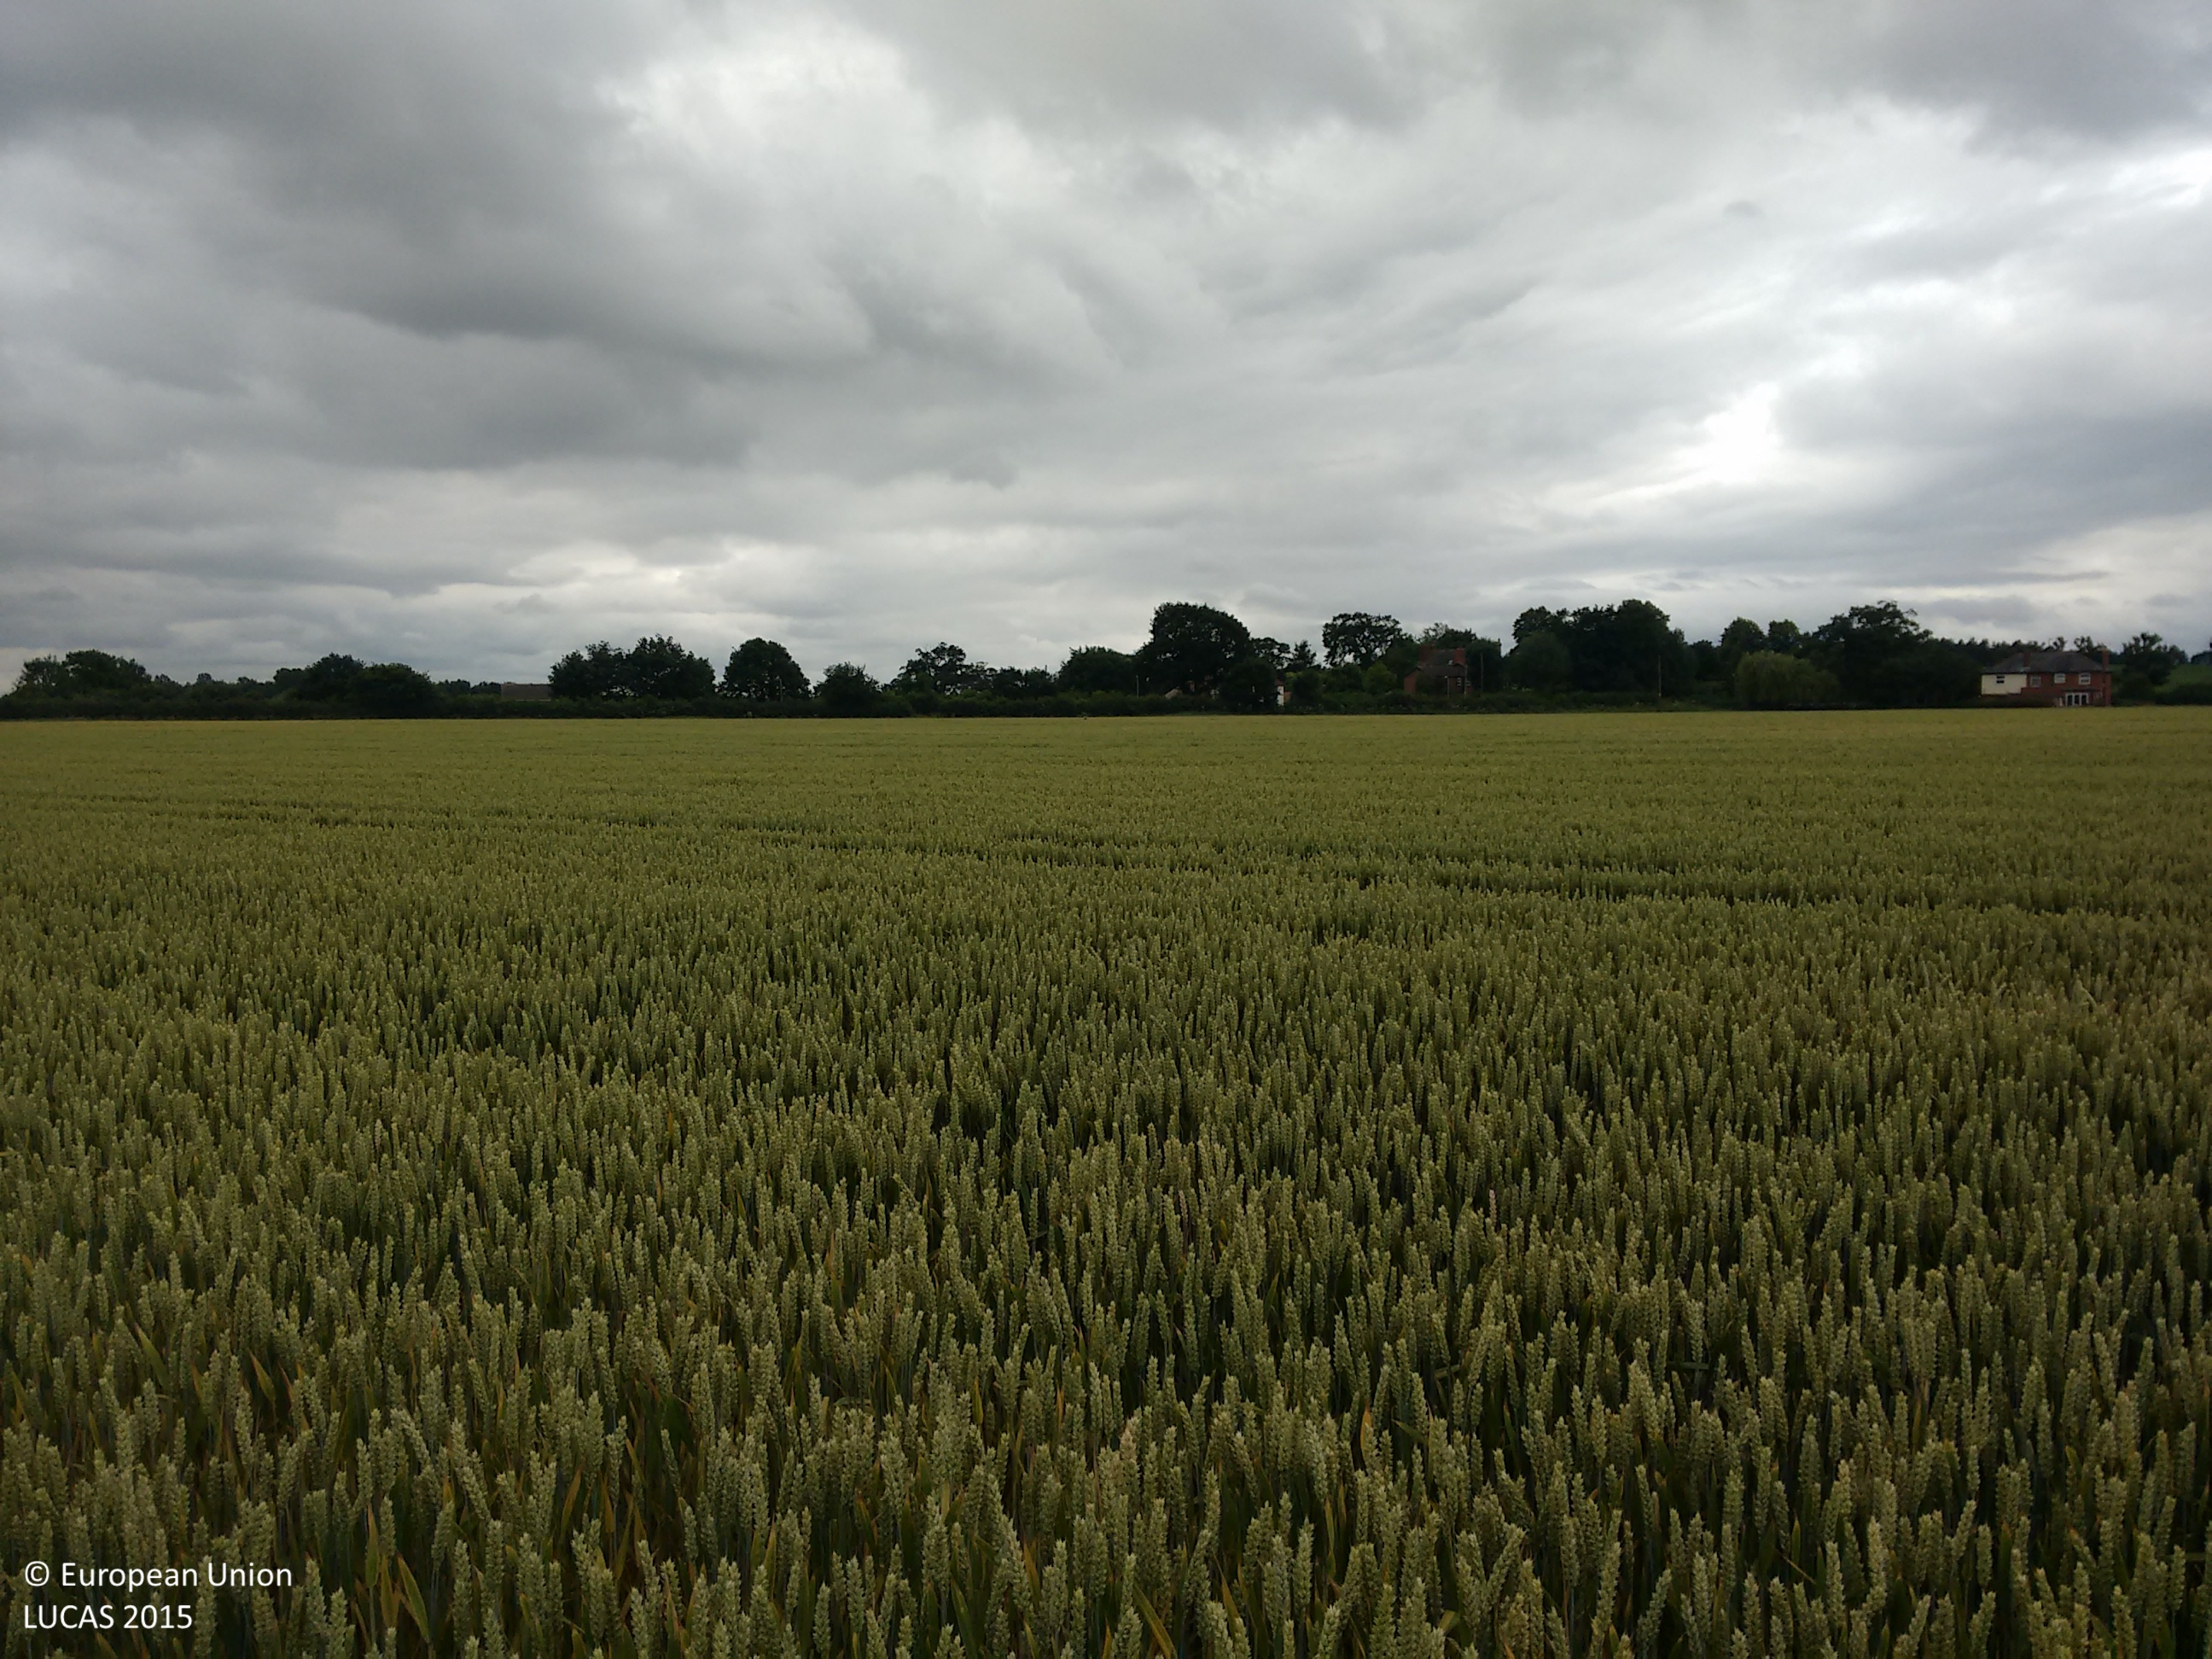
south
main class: Cropland
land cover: Common wheat
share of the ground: > 75 %
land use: Agriculture (excluding fallow land and kitchen gardens)
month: July
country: GB
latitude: 53.3533
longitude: -0.9957
